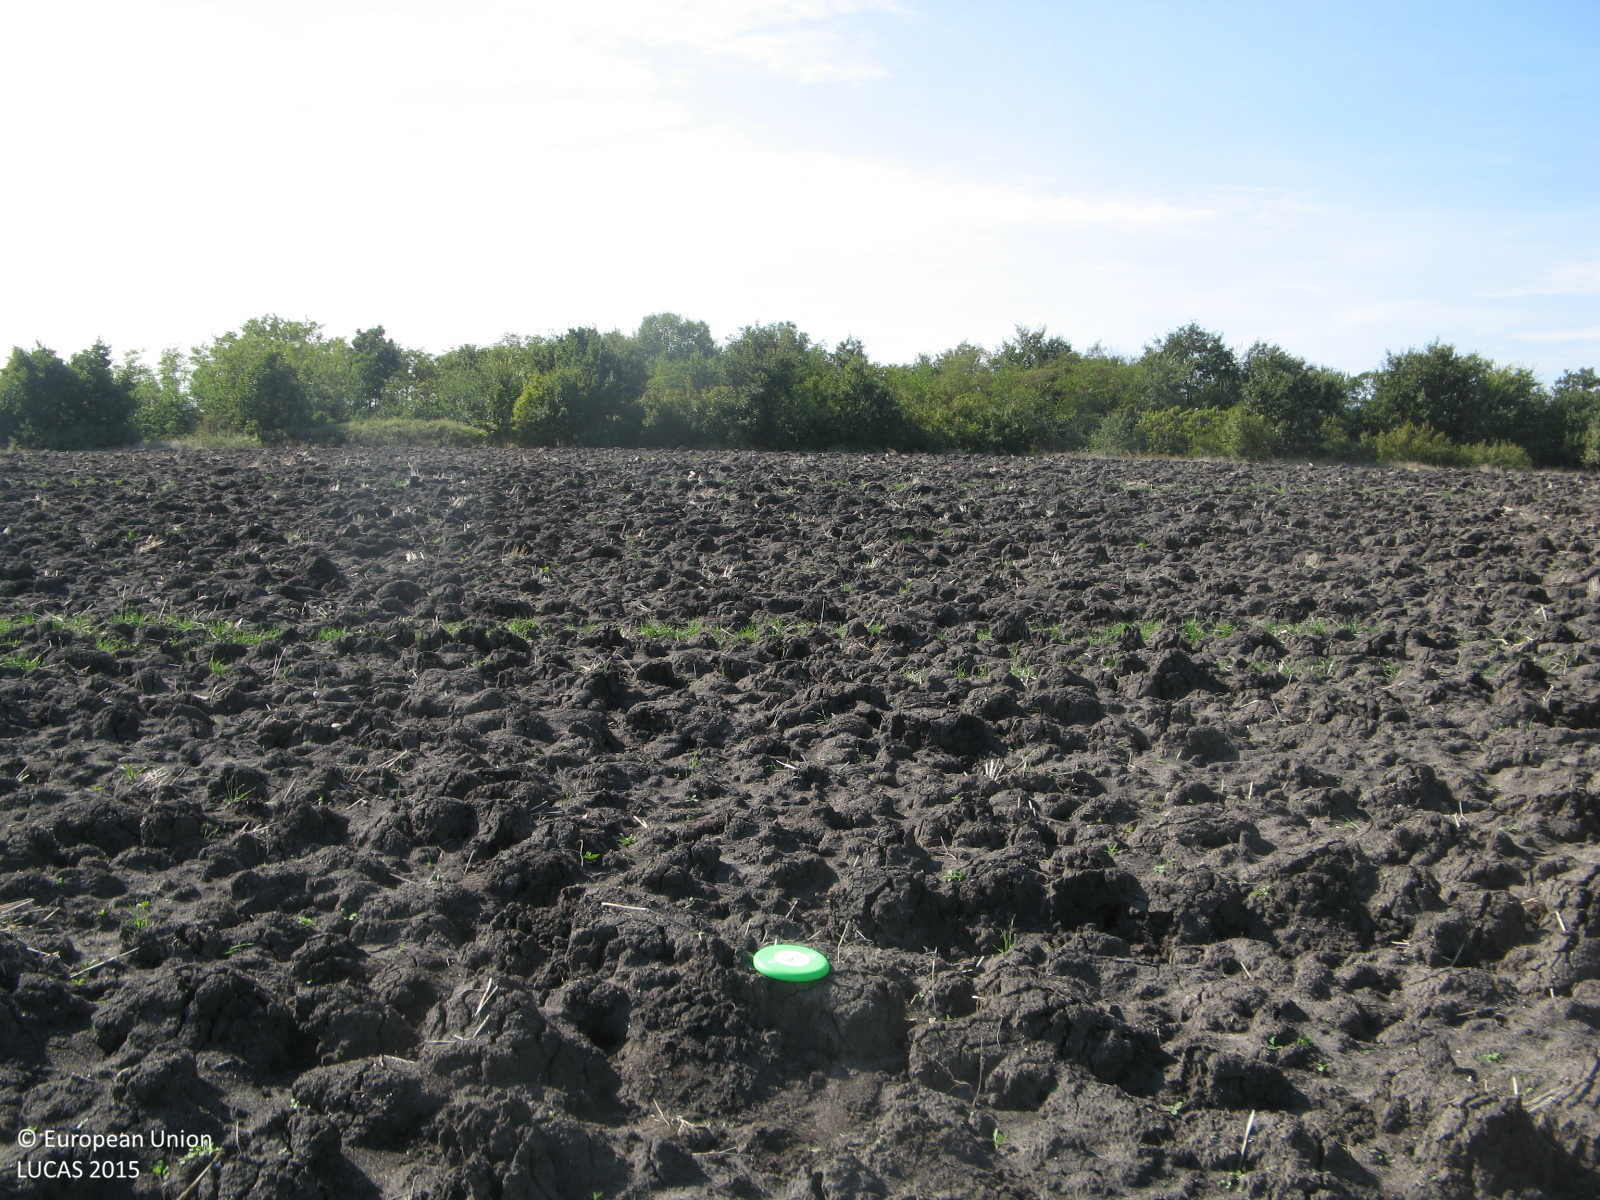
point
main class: Cropland
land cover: Common wheat
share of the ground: < 10 %
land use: Agriculture (excluding fallow land and kitchen gardens)
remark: Harvested field
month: October
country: BG
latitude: 41.9131
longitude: 25.6057
